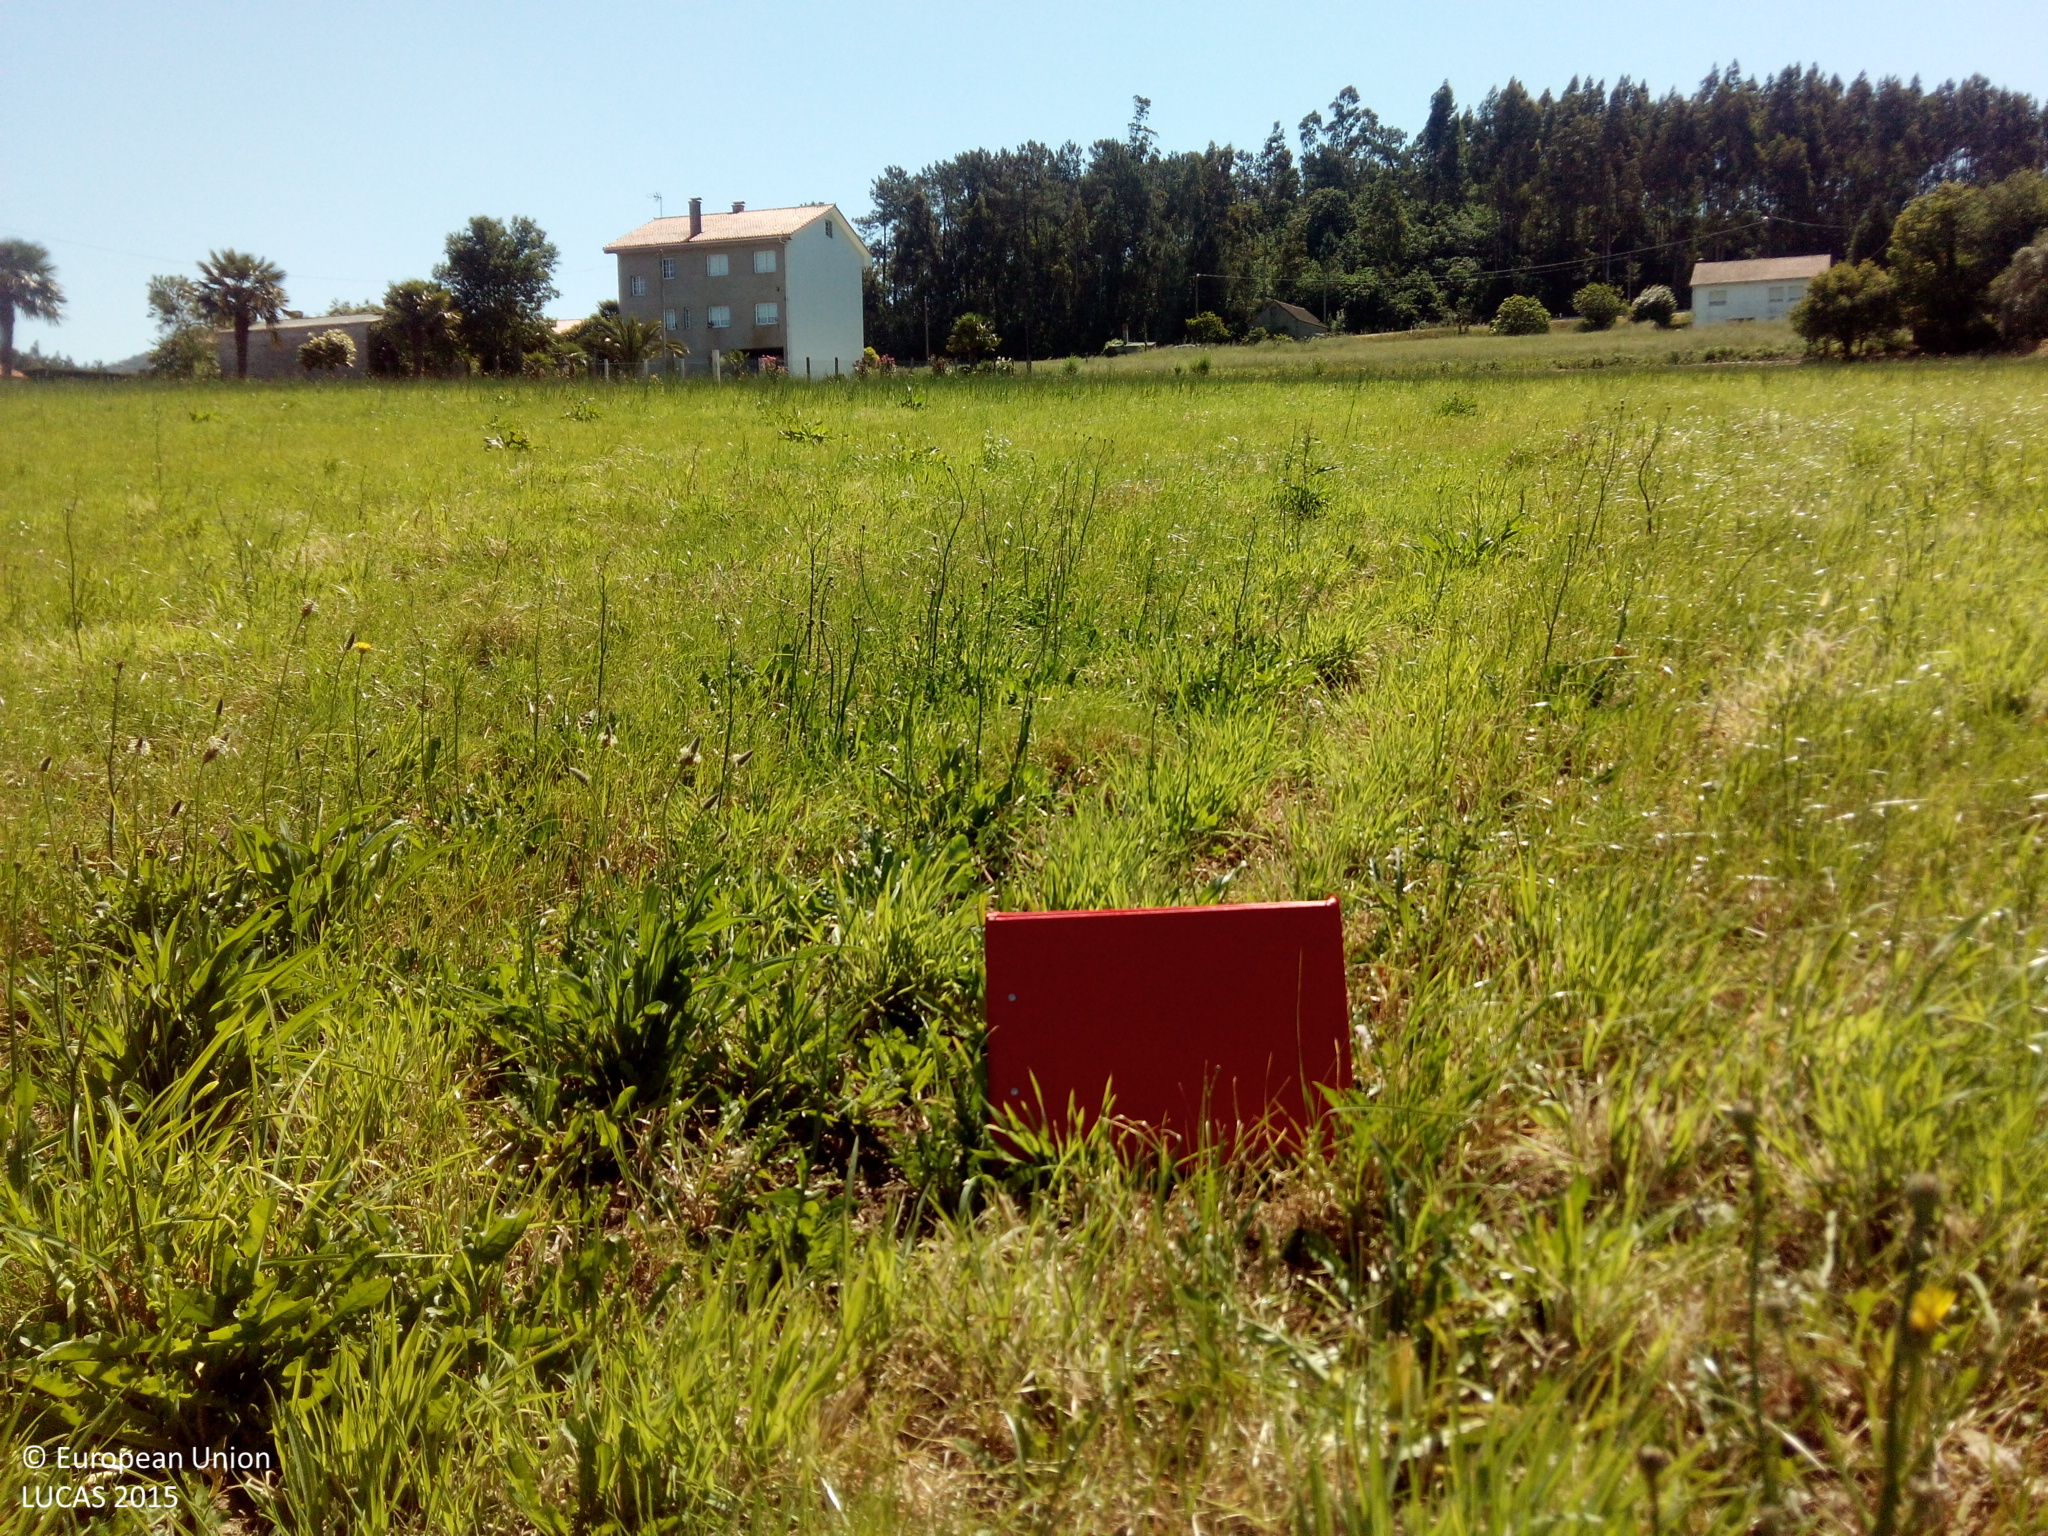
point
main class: Grassland
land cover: Grassland without tree/shrub cover
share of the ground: > 75 %
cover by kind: herbaceous plants 100 %
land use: Agriculture (excluding fallow land and kitchen gardens)
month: May
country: ES
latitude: 42.8021
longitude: -8.4797
